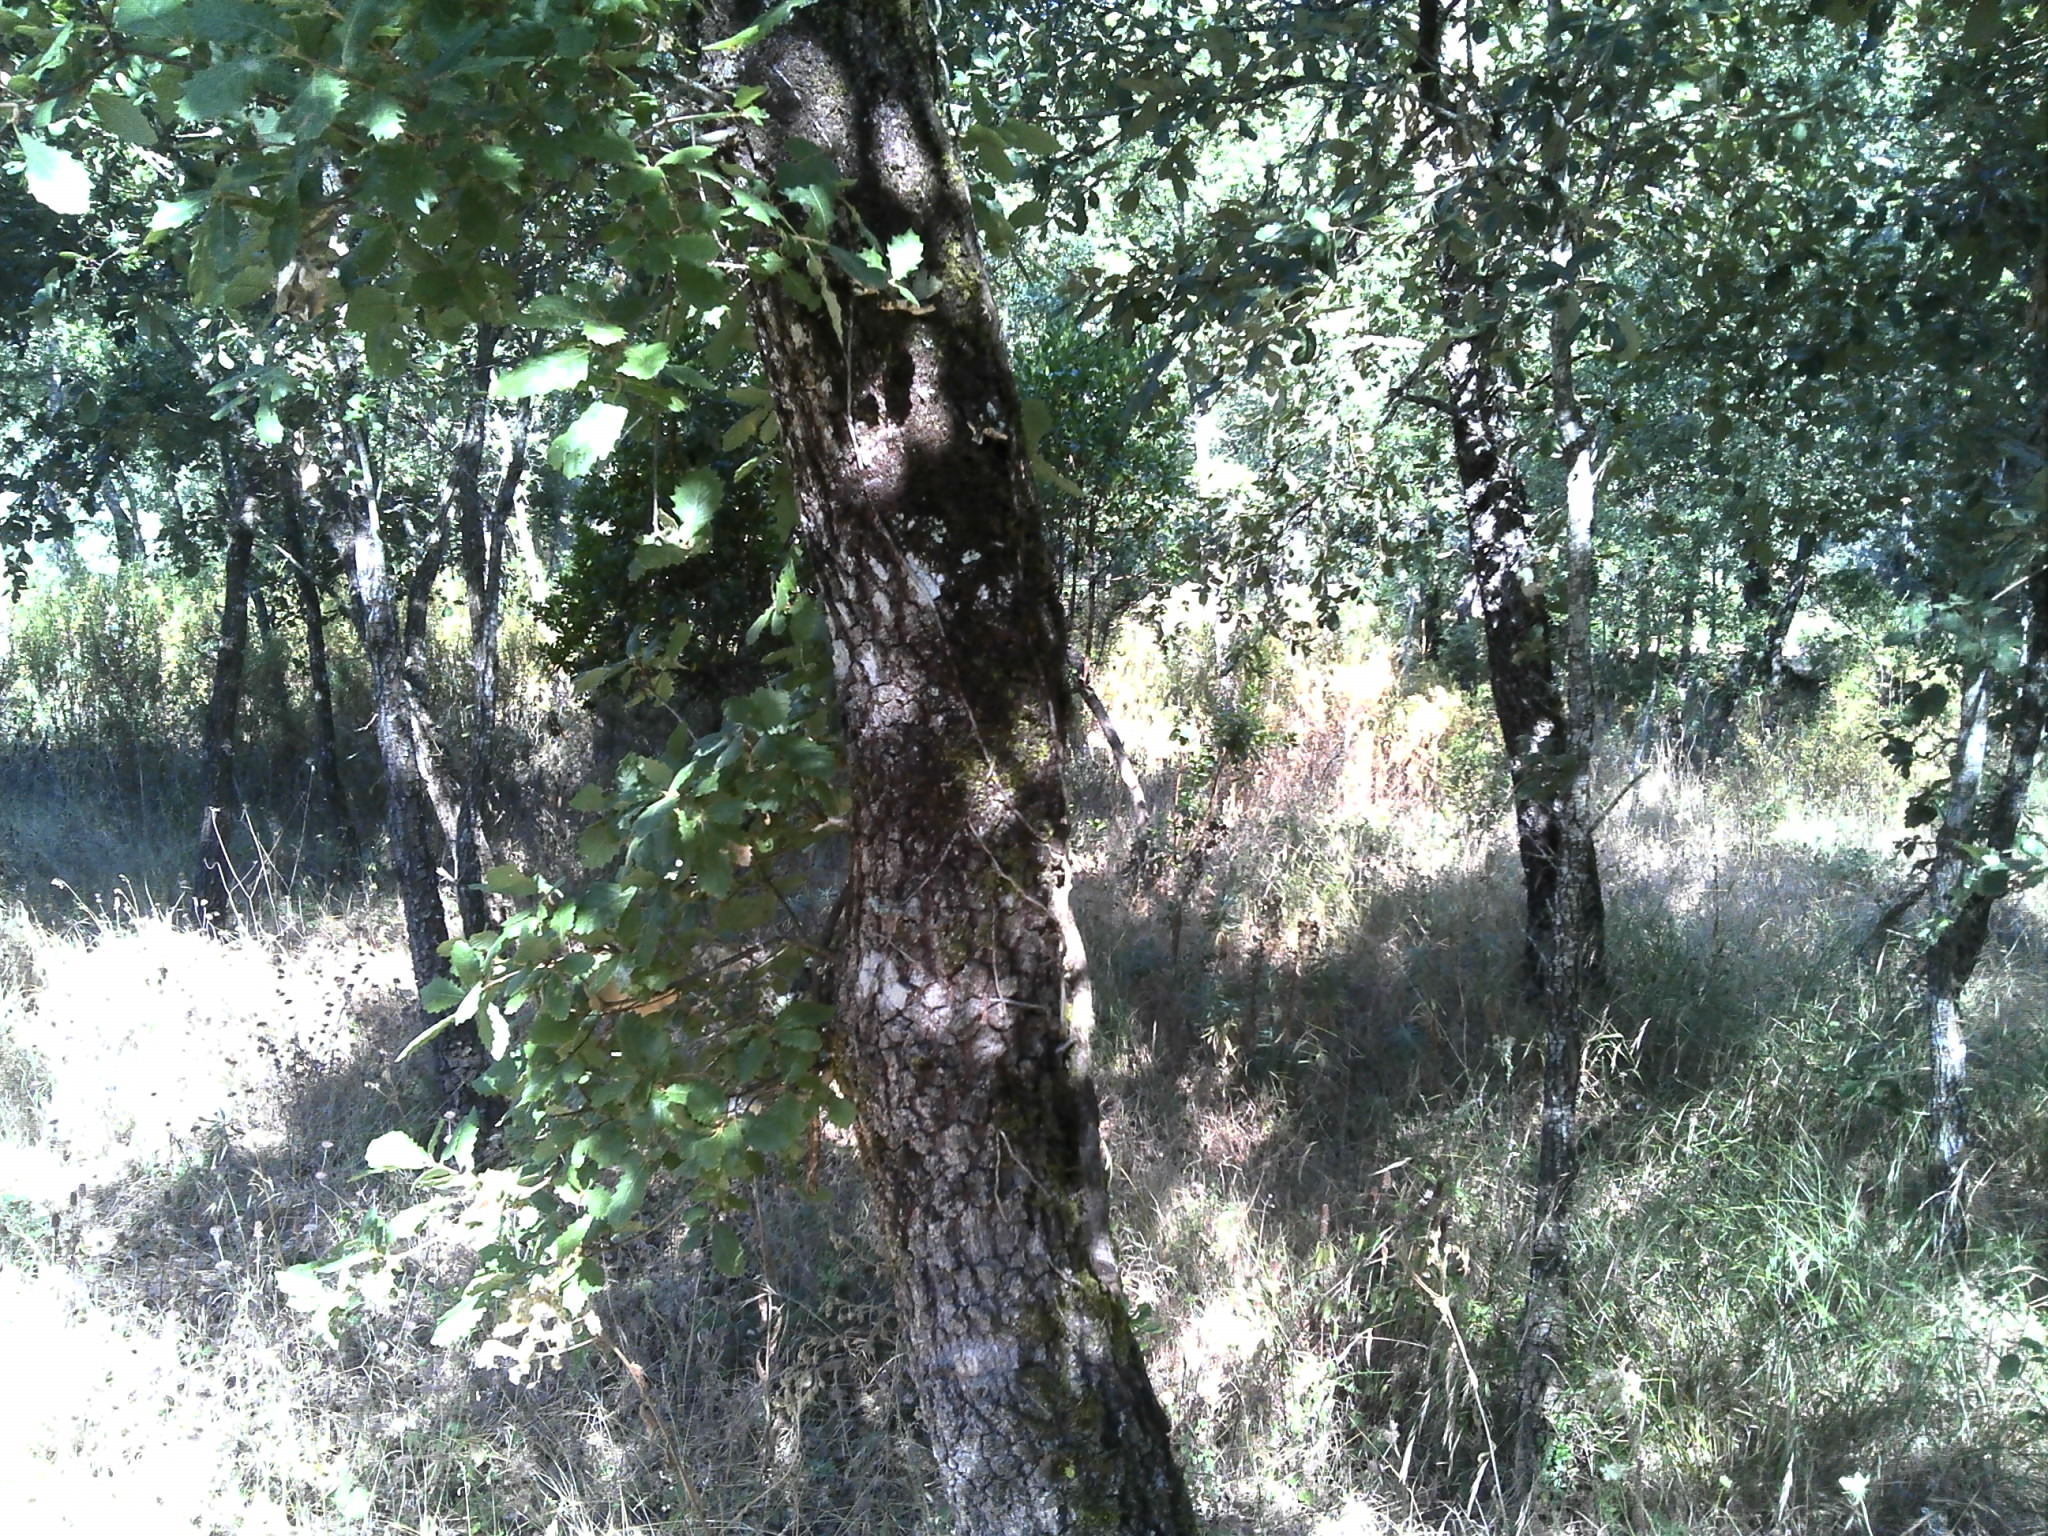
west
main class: Woodland
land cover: Broadleaved woodland
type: broadleaved evergreen forest
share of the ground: 10 - 25 %
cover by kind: herbaceous plants 80 %, broadleaved forest trees 20 %
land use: Forestry
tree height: > 5 m
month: July
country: PT
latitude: 39.9053
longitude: -8.4550
